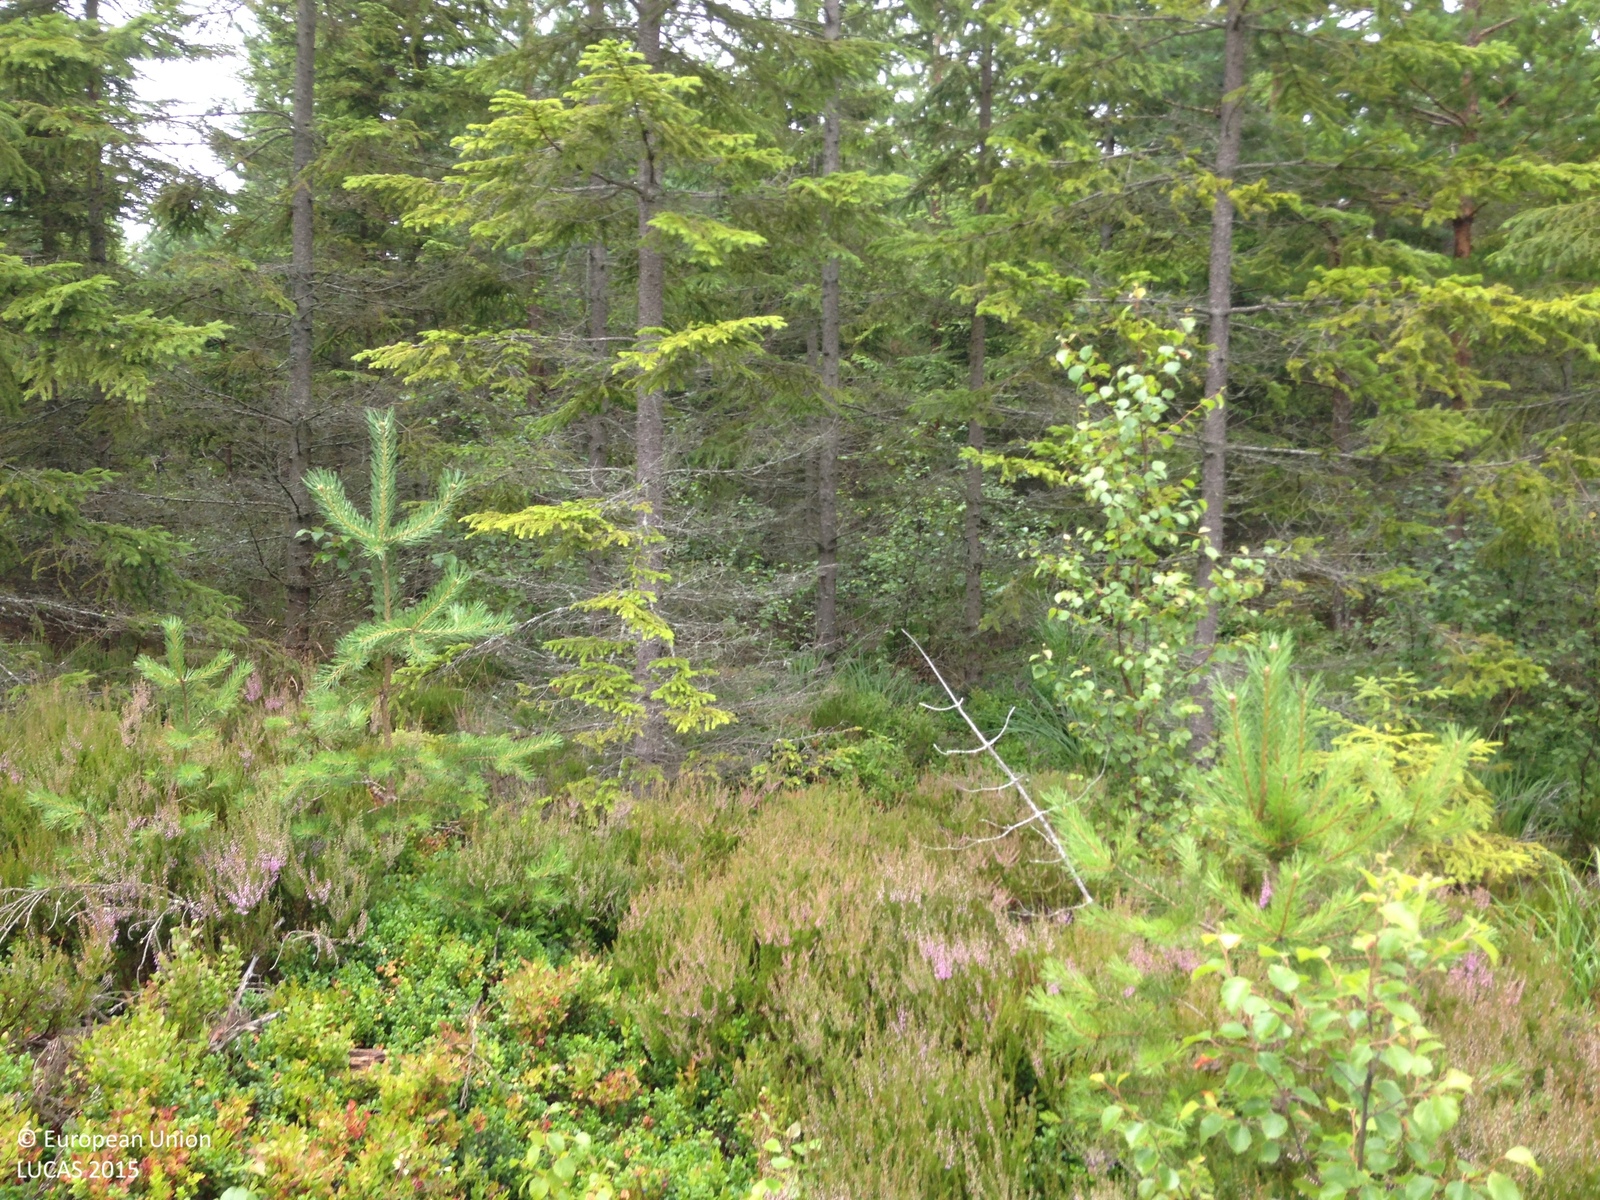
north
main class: Woodland
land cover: Broadleaved woodland
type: hemiboreal forest and nemoral coniferous forest and mixed broadleaved-coniferous forest
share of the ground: 25 - 50 %
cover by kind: broadleaved forest trees 40 %, herbaceous plants 30 %, shrubs 25 %, coniferous forest trees 5 %
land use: Forestry
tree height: < 5 m
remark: Clear cut
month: July
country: SE
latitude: 59.0439
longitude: 14.5413
